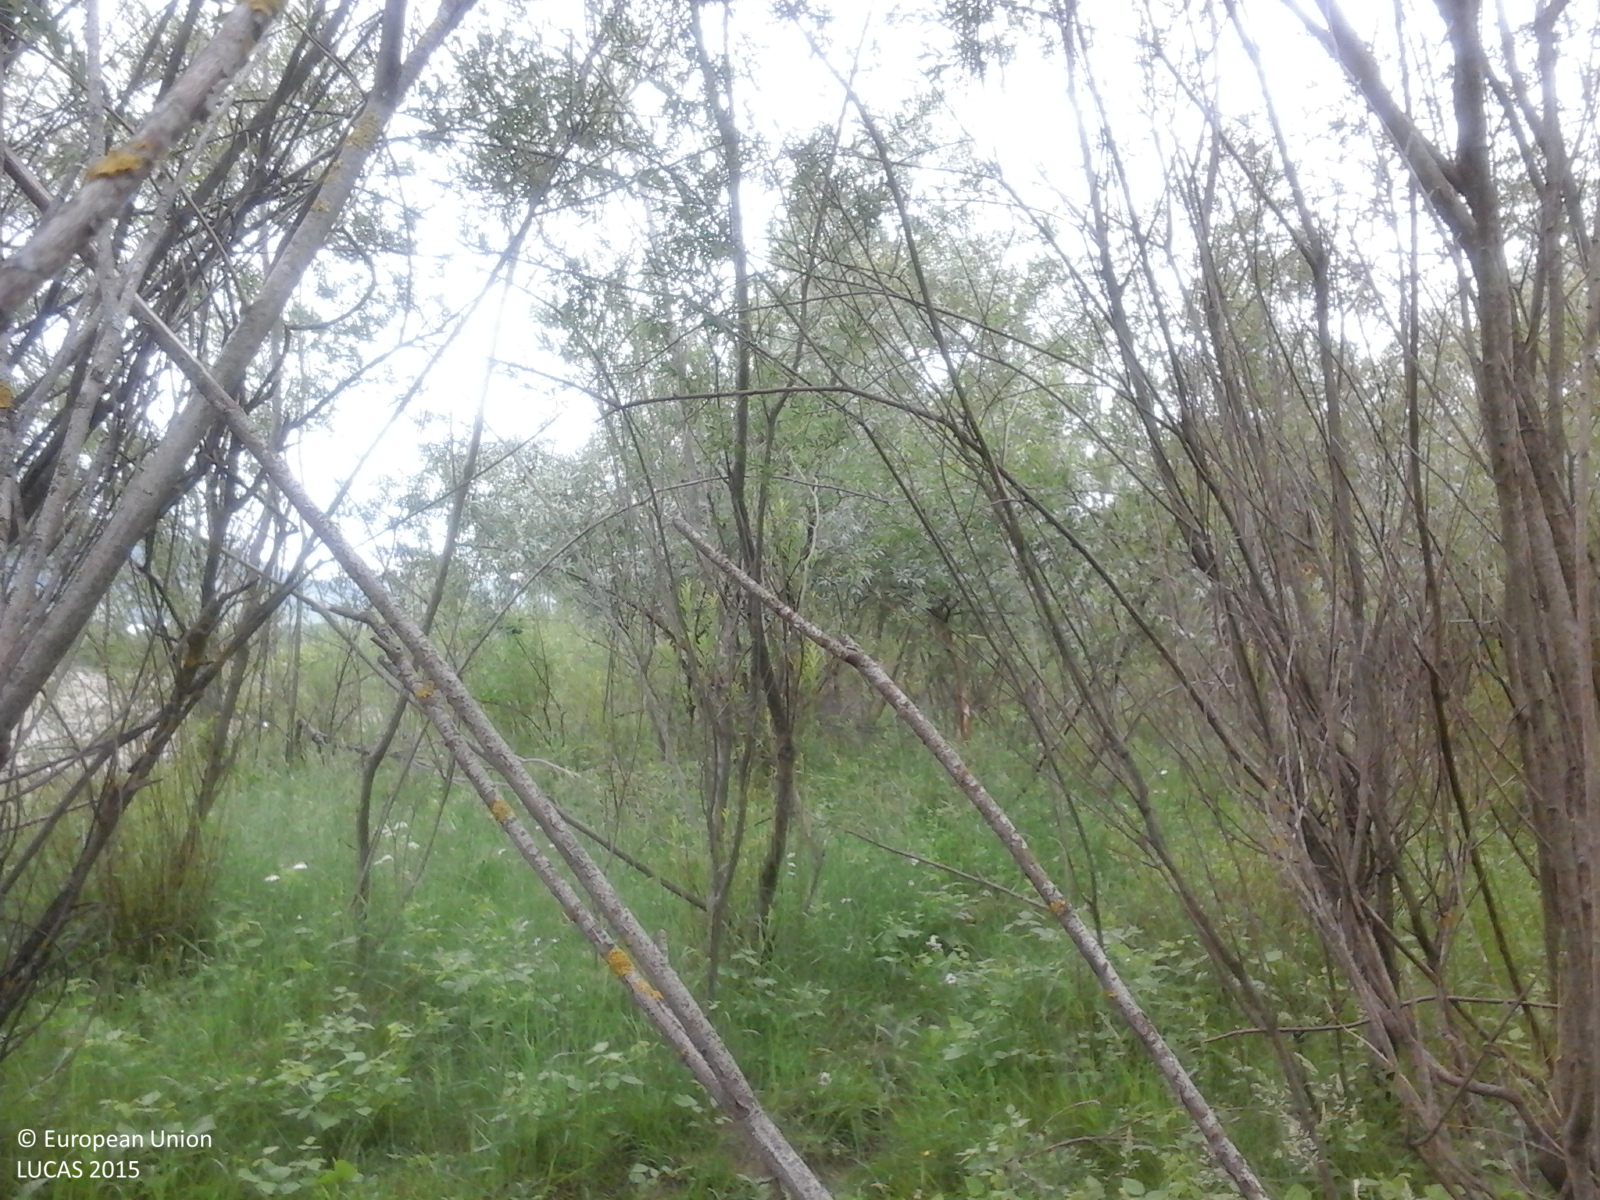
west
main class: Woodland
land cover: Broadleaved woodland
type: thermophilous deciduous forest
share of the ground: > 75 %
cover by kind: broadleaved forest trees 85 %, herbaceous plants 15 %
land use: Semi-natural and natural areas not in use
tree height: > 5 m
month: June
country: RO
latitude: 47.9163
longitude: 25.6856
